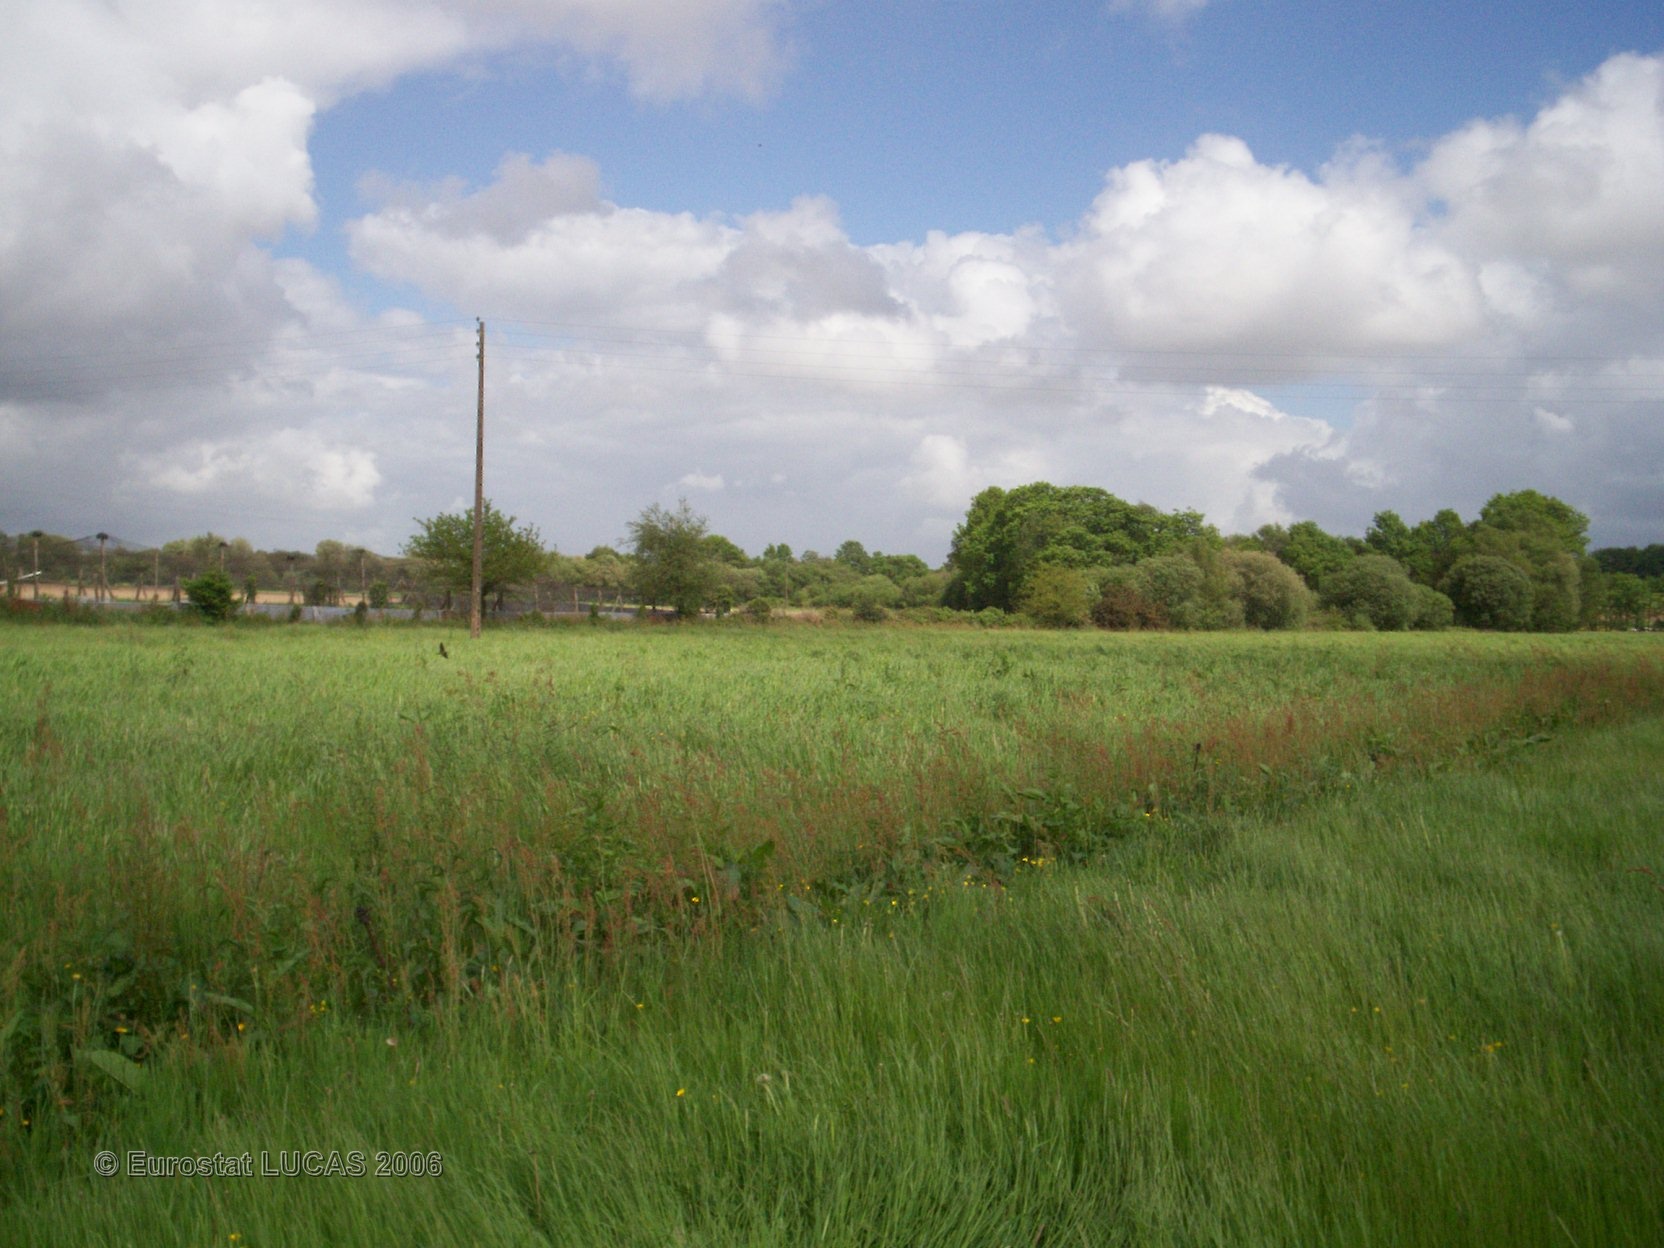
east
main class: Grassland
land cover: Grassland without tree/shrub cover
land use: Agriculture (excluding fallow land and kitchen gardens)
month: May
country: FR
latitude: 47.9092
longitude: -2.8145
